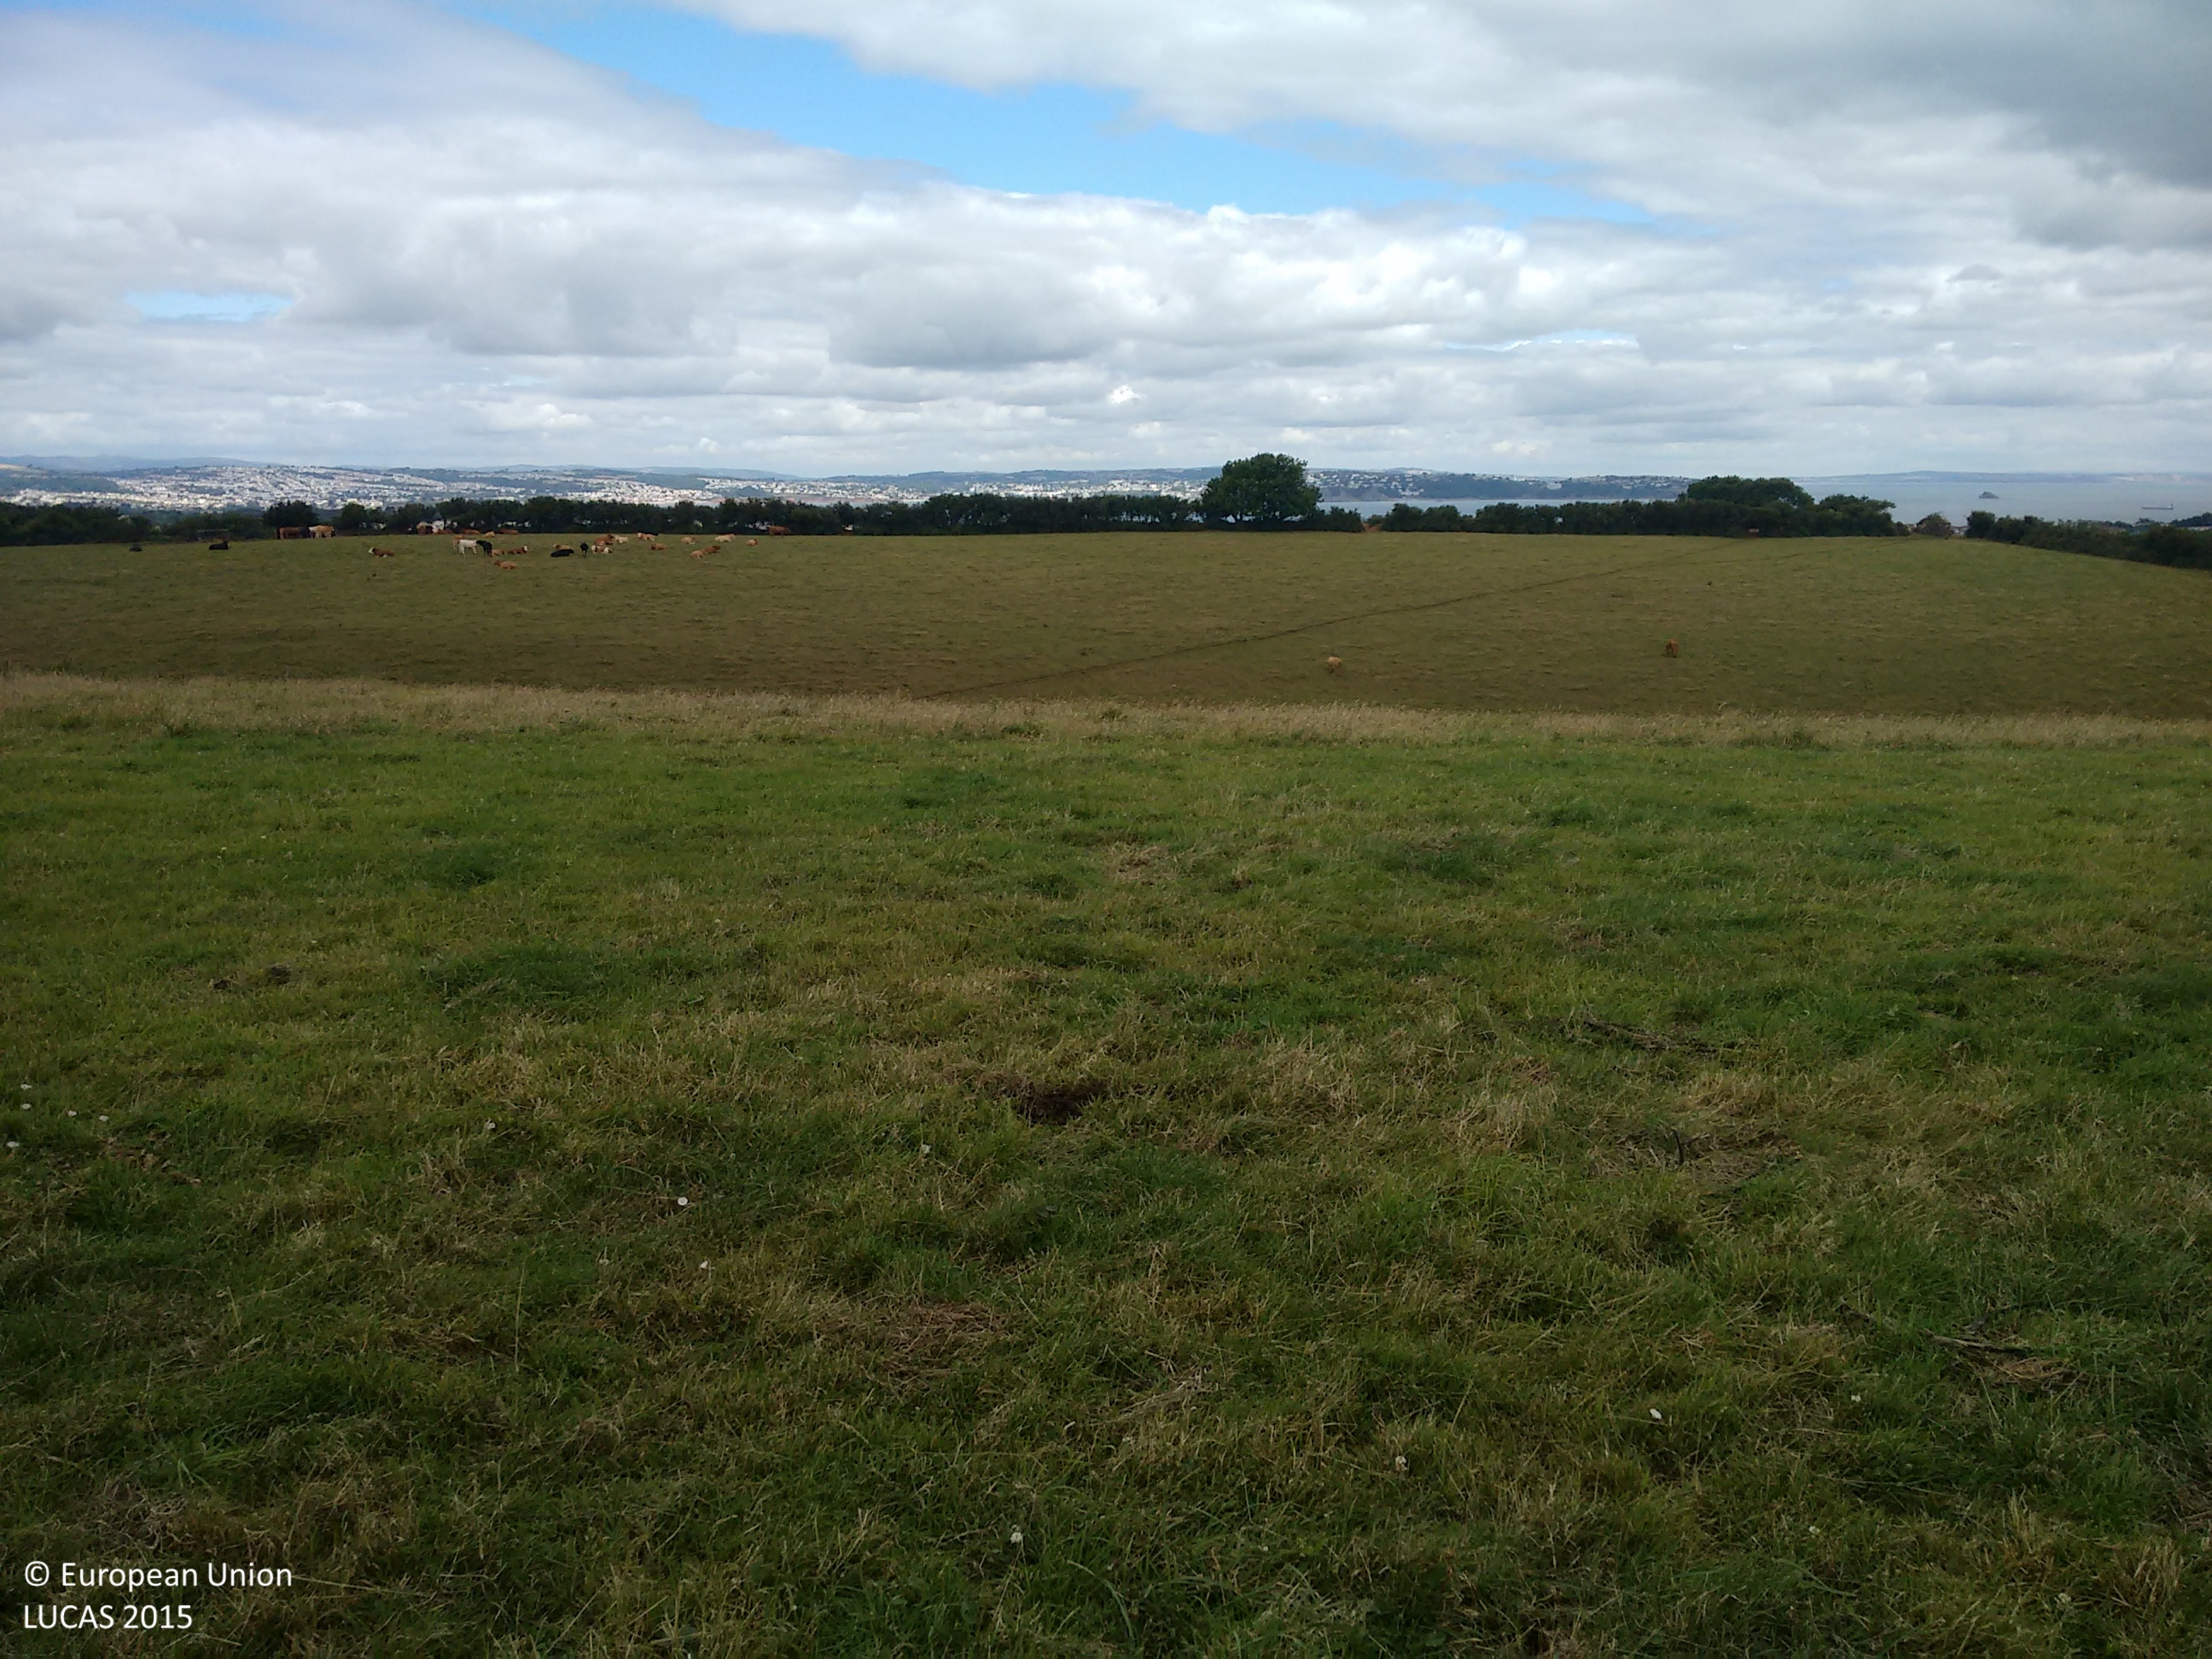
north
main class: Grassland
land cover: Grassland without tree/shrub cover
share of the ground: > 75 %
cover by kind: herbaceous plants 85 %, unconsolidated bare surface 15 %
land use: Agriculture (excluding fallow land and kitchen gardens)
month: July
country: GB
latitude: 50.3781
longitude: -3.5130
